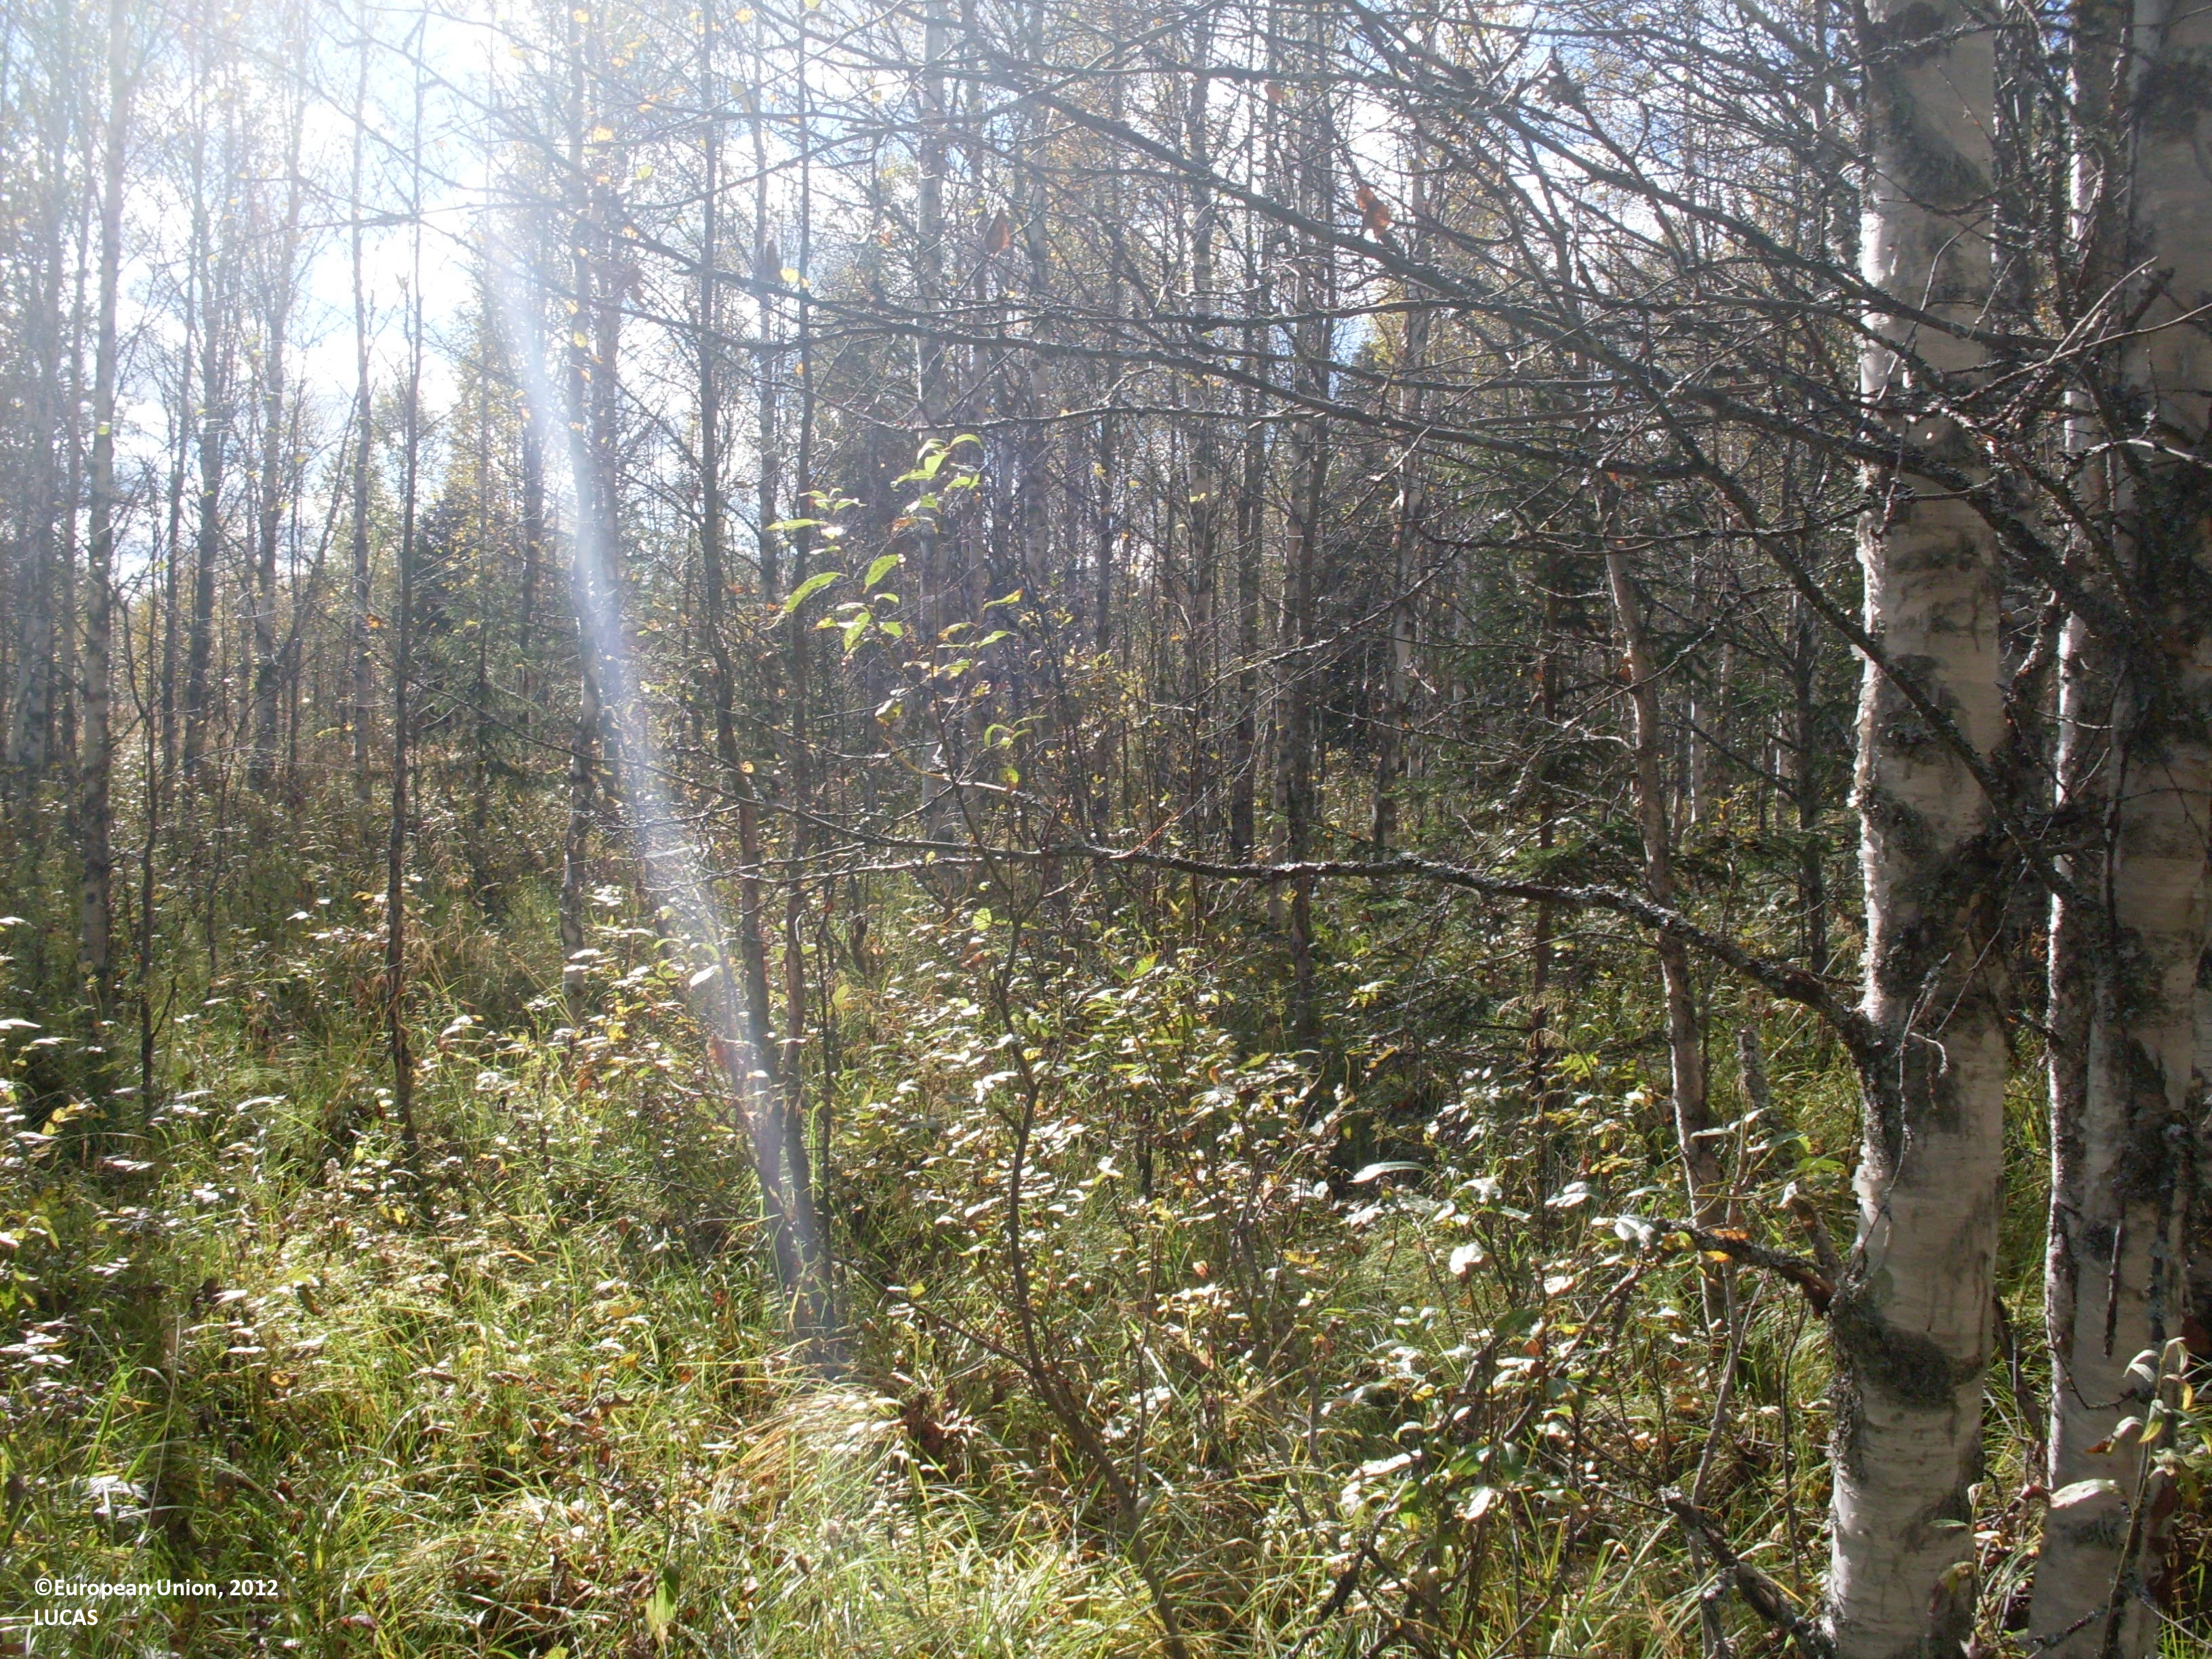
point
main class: Woodland
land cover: Other mixed woodland
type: boreal forest
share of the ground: 50 - 75 %
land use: Forestry
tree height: > 5 m
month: September
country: FI
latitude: 64.1093
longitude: 30.0492
